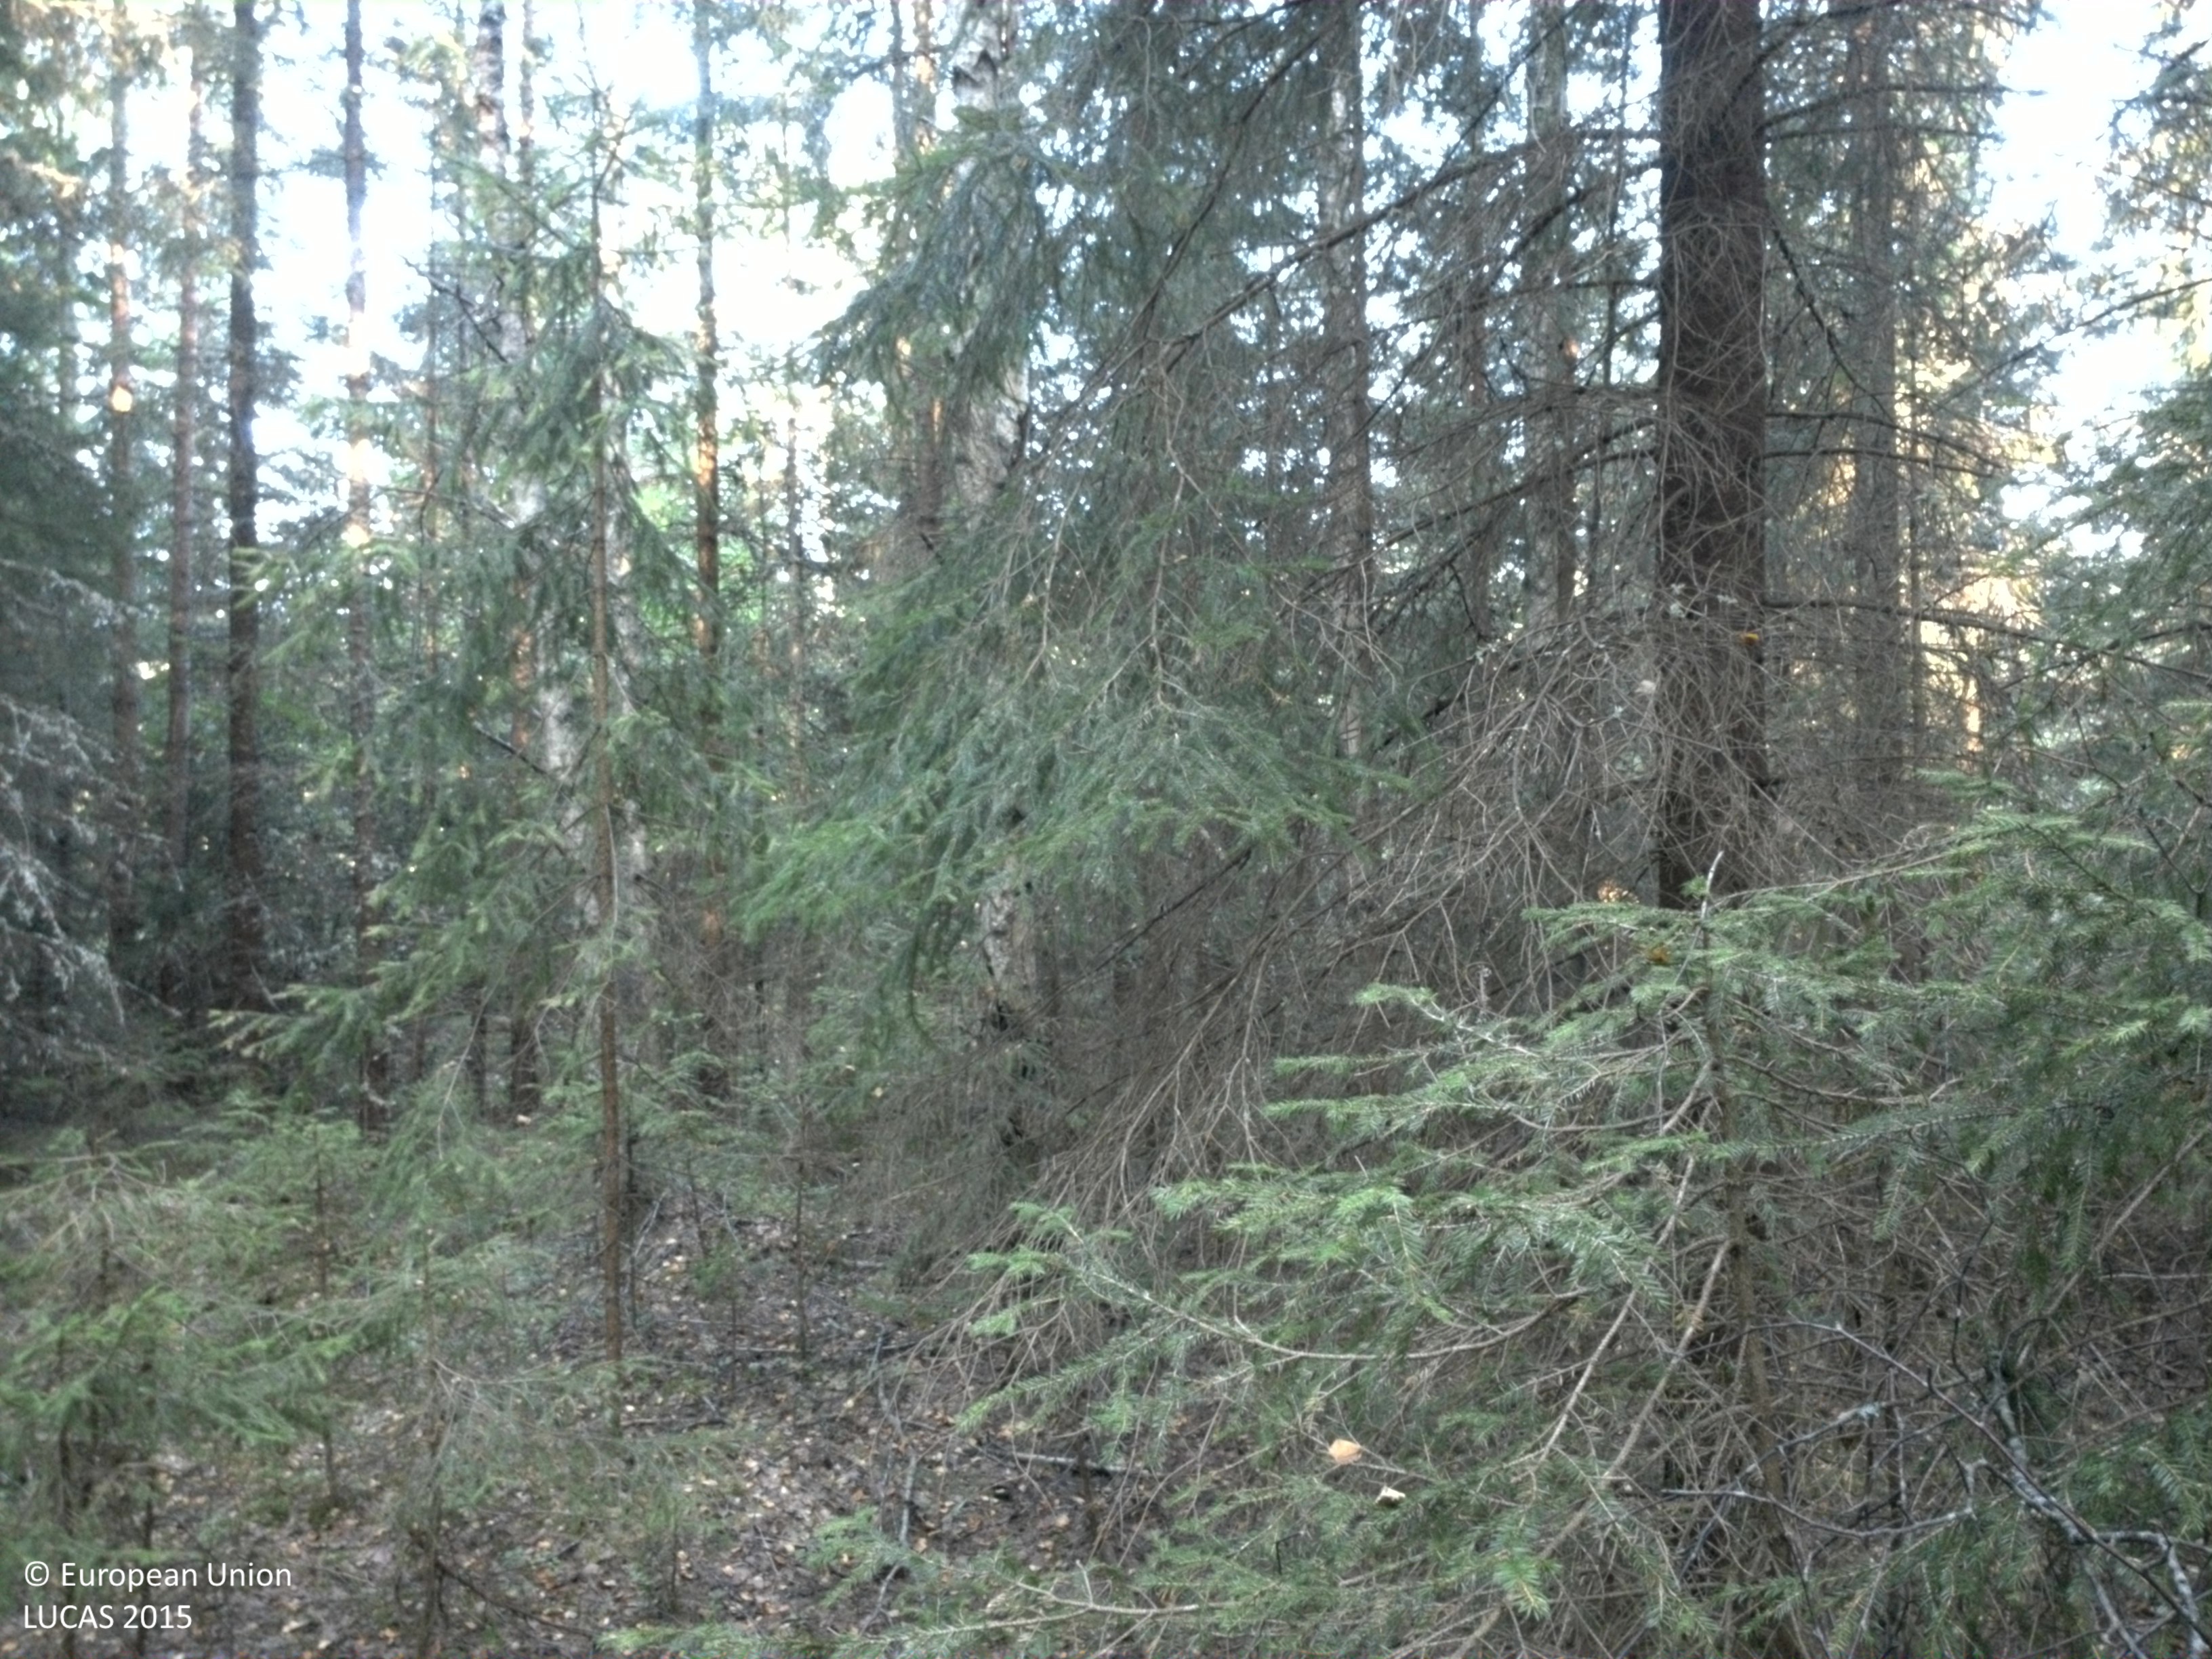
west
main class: Woodland
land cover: Spruce dominated coniferous woodland
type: boreal forest
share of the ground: 50 - 75 %
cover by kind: coniferous forest trees 65 %, lichens and mosses 20 %, broadleaved forest trees 5 %, shrubs 5 %, herbaceous plants 5 %
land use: Forestry
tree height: > 5 m
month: August
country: SE
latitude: 59.5459
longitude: 13.3704
